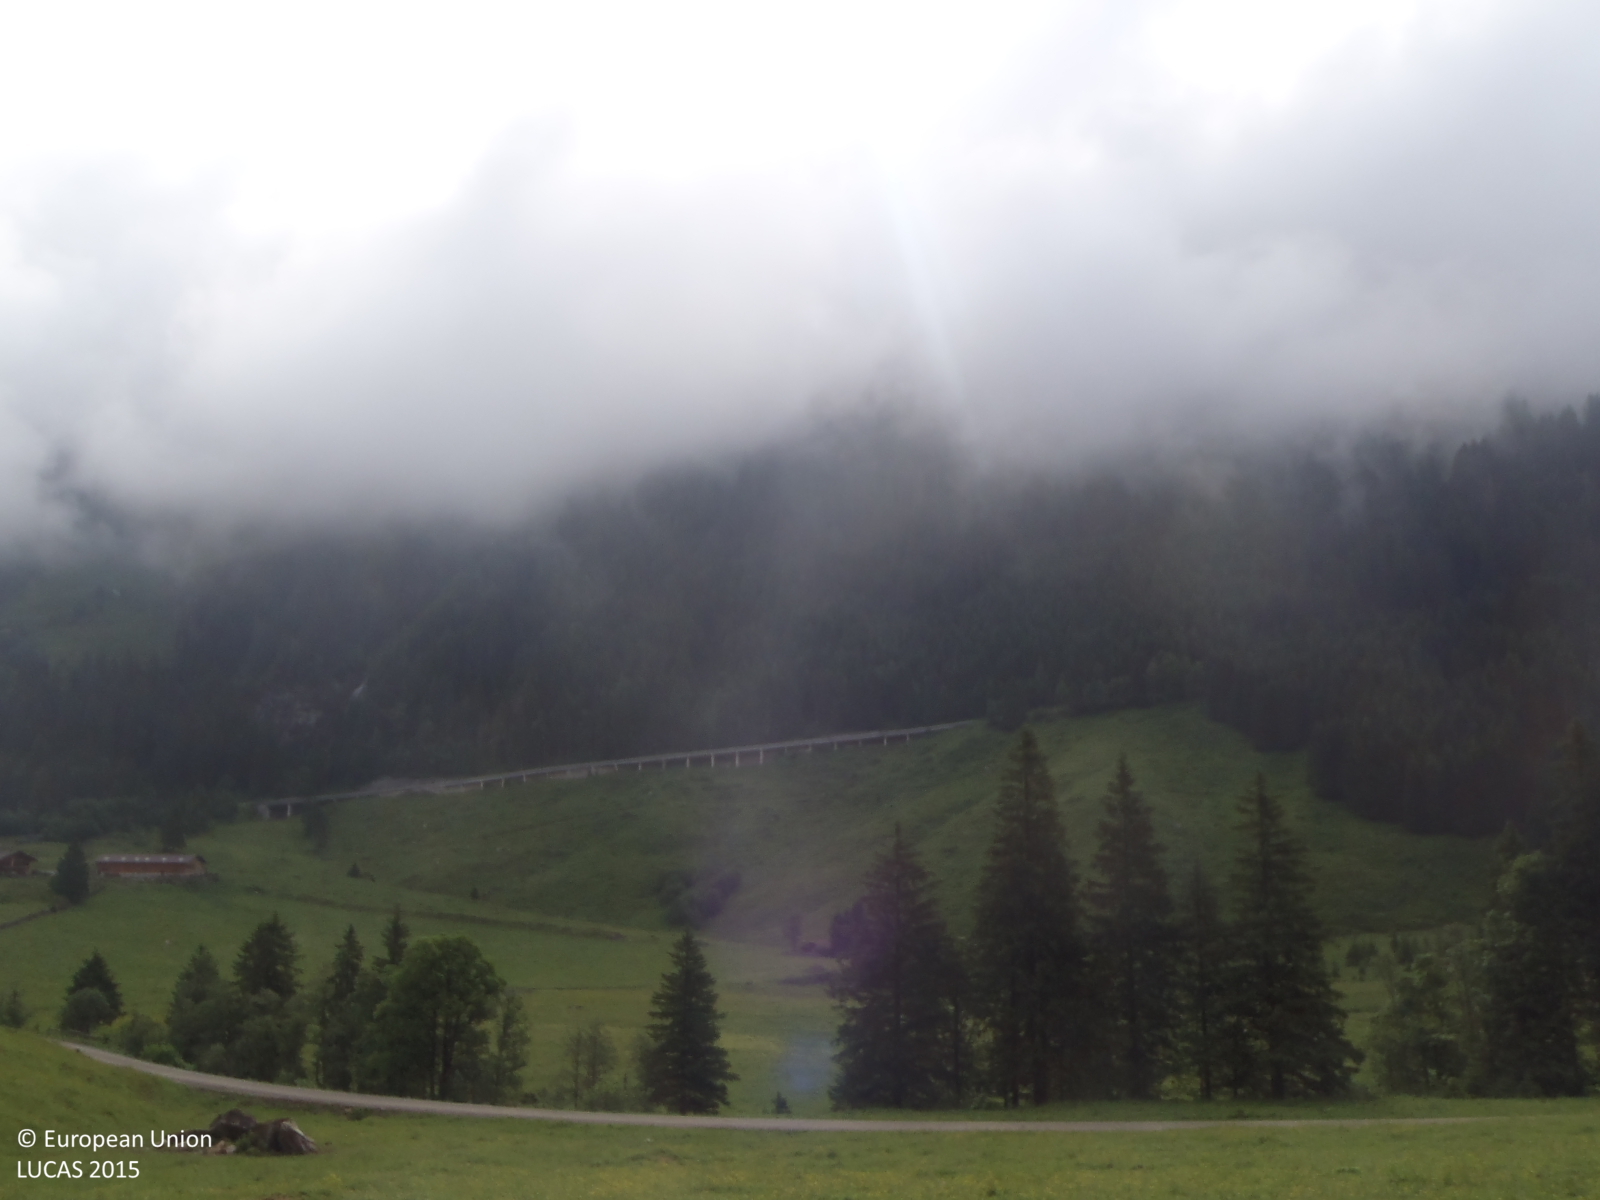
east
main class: Grassland
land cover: Grassland without tree/shrub cover
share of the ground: > 75 %
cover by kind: herbaceous plants 100 %
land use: Agriculture (excluding fallow land and kitchen gardens)
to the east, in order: Grassland without tree/shrub cover; Tracks; Grassland without tree/shrub cover; Shrubland with sparse tree cover; Fences; Inland fresh running water; Spruce dominated coniferous woodland; Tracks; Grassland without tree/shrub cover
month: June
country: AT
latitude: 47.1613
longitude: 12.8076
